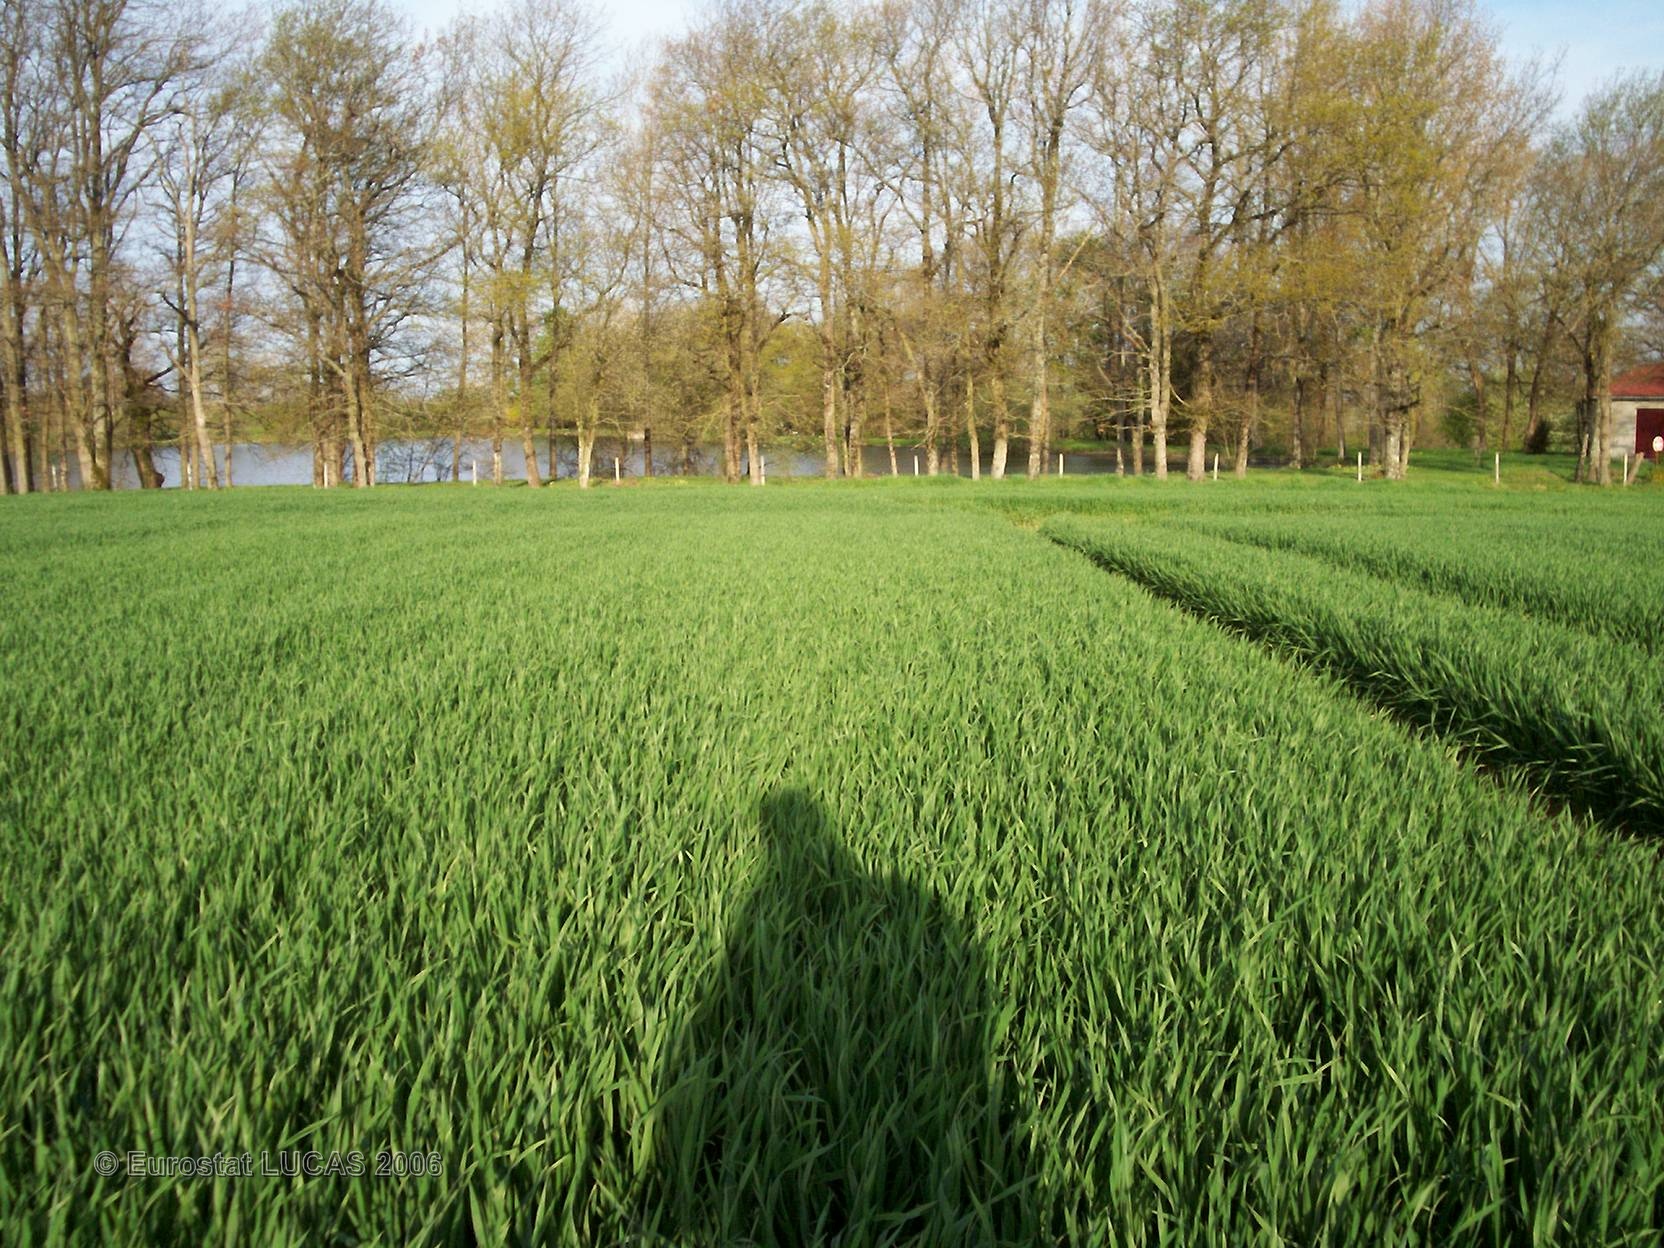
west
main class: Cropland
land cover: Common wheat
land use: Agriculture (excluding fallow land and kitchen gardens)
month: April
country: FR
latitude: 46.5815
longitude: 1.5990
